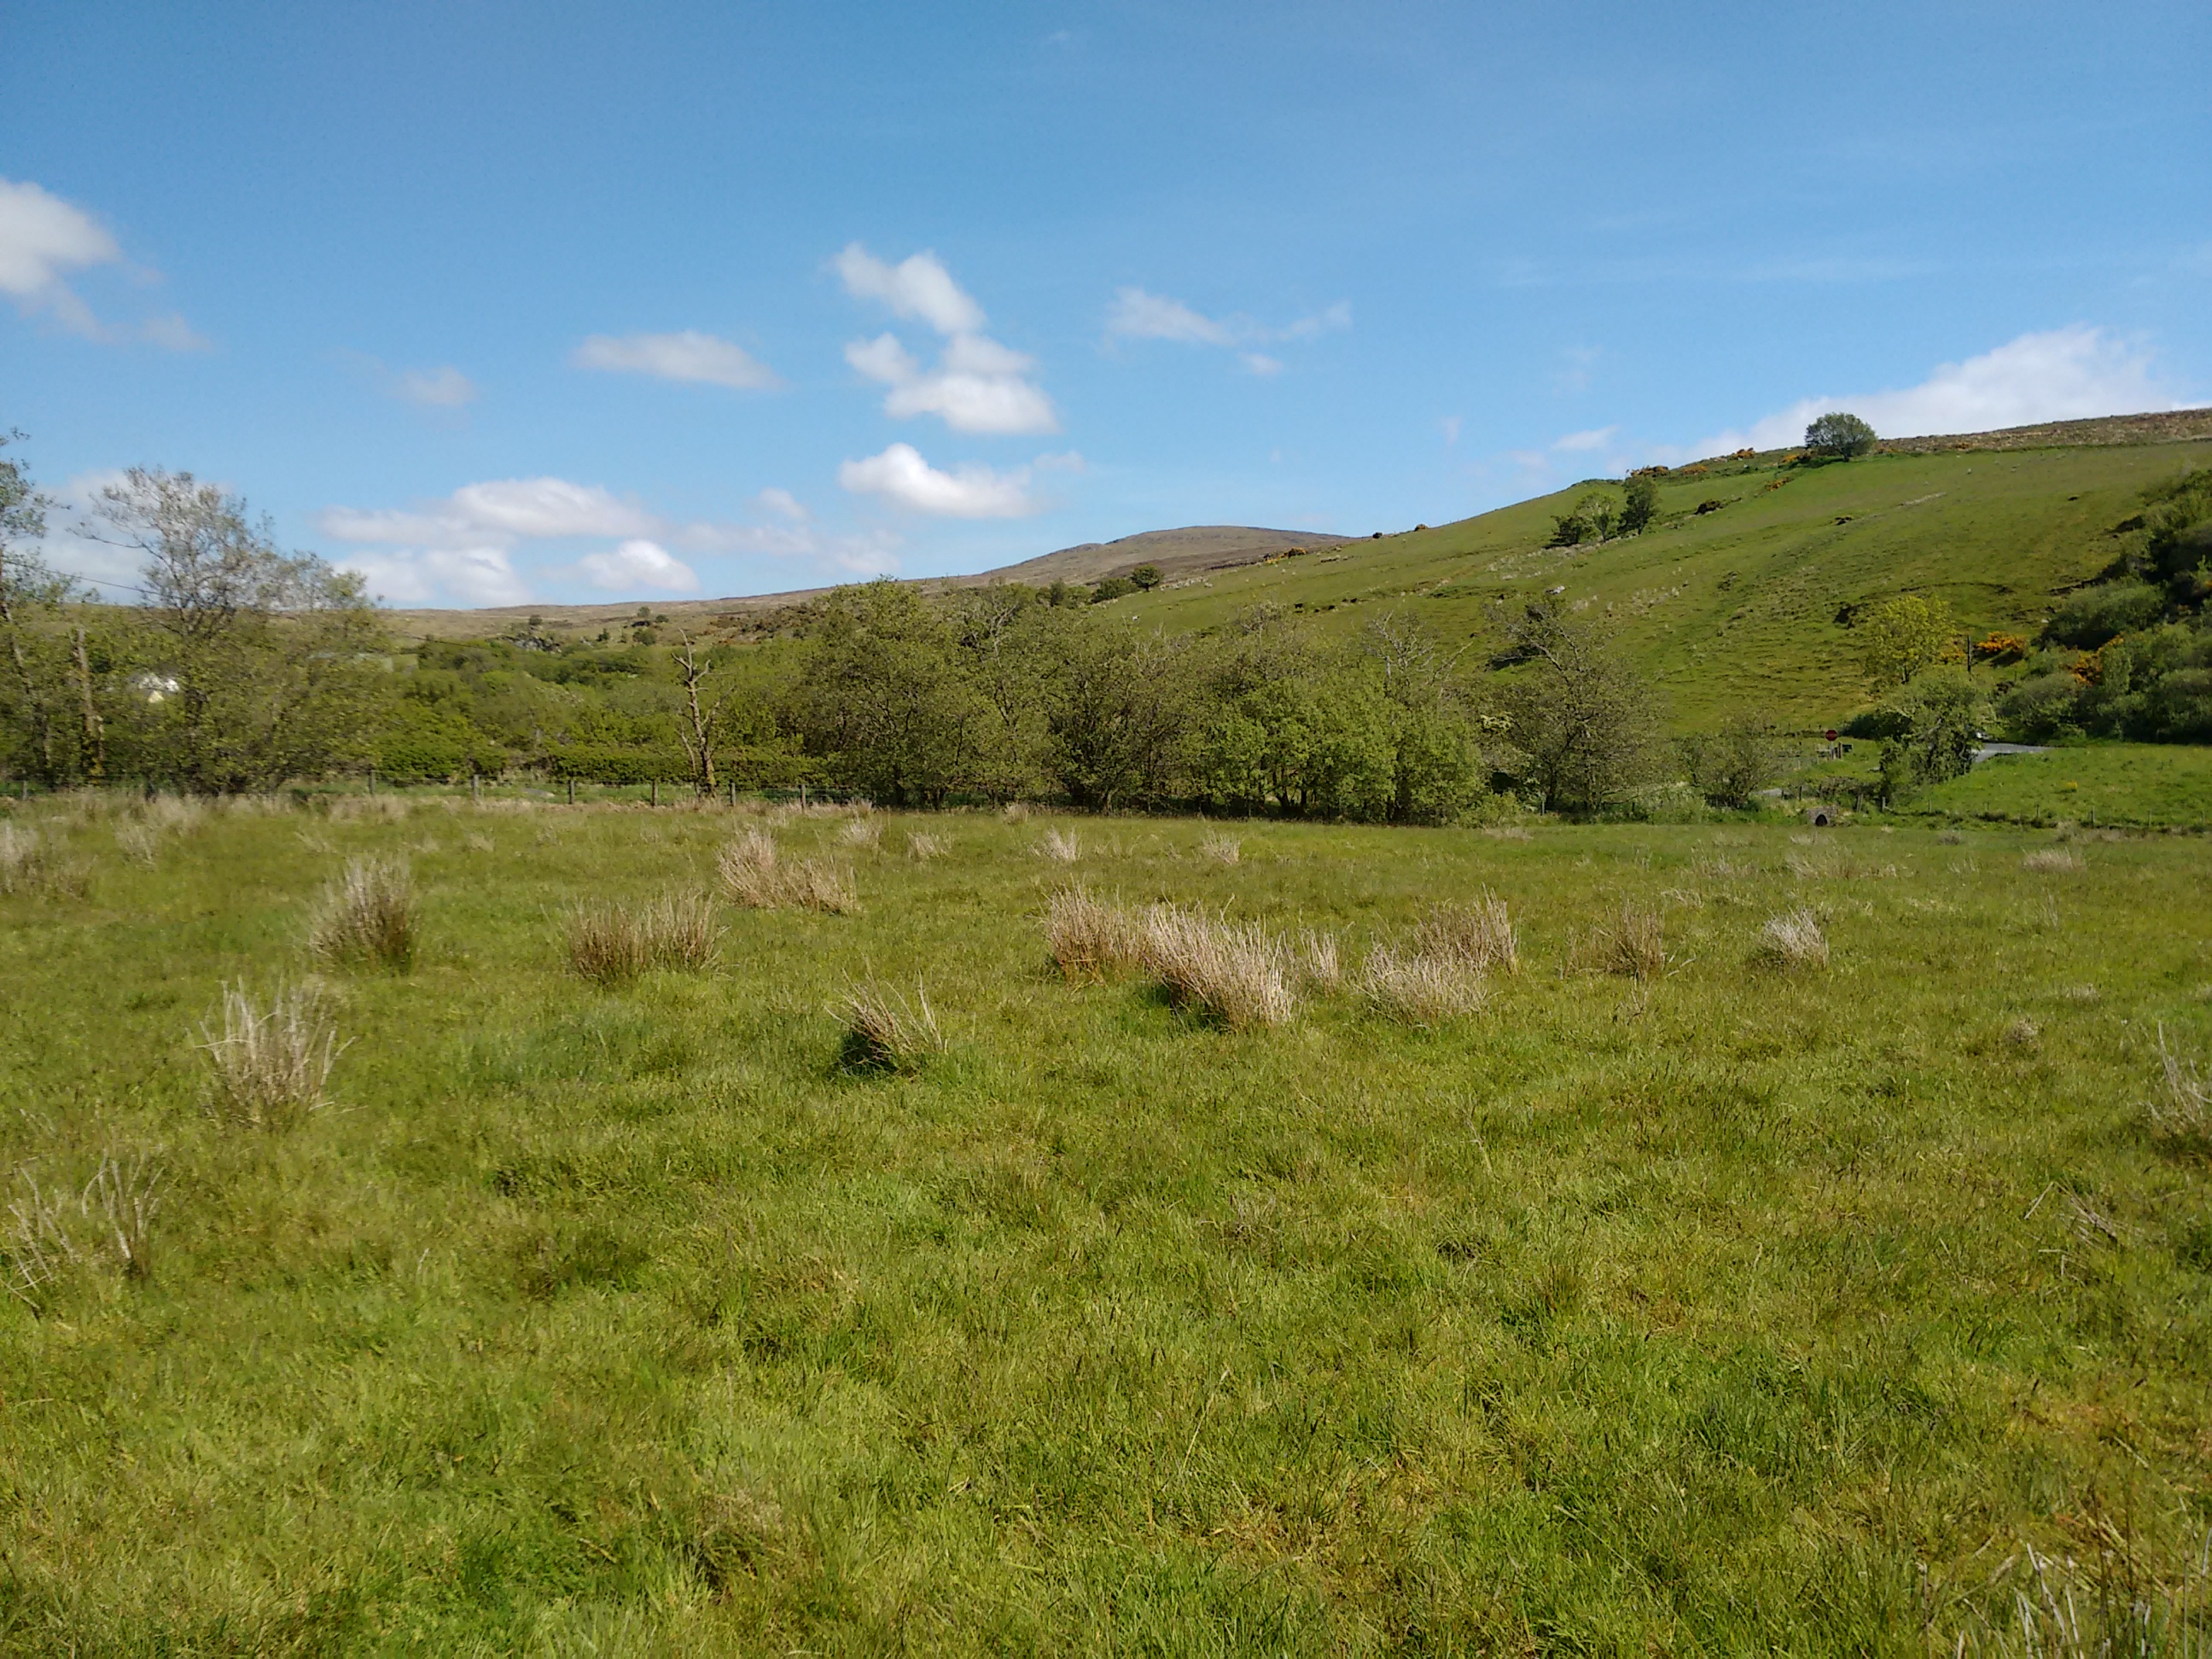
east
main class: Grassland
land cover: Grassland without tree/shrub cover
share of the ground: > 75 %
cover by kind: herbaceous plants 100 %
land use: Agriculture (excluding fallow land and kitchen gardens)
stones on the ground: < 10 %
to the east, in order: Grassland without tree/shrub cover; Ditches and canals; Grassland without tree/shrub cover; Ditches and canals; Fences; Abandoned hedges; Ditches and canals; Grass margins; Paved roads, cycling and walking lanes; Grass margins; Fences; Abandoned hedges; Rivers and streams; Grassland with sparse tree/shrub cover; Fences; Single bushes/trees; Grassland without tree/shrub cover; Ditches and canals; Fences; Grassland without tree/shrub cover; Fences; Single bushes/trees; Grassland without tree/shrub cover; Paved roads, cycling and walking lanes; Grass margins; Fences; Grassland without tree/shrub cover
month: June
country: GB
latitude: 54.8038
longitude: -7.2436
